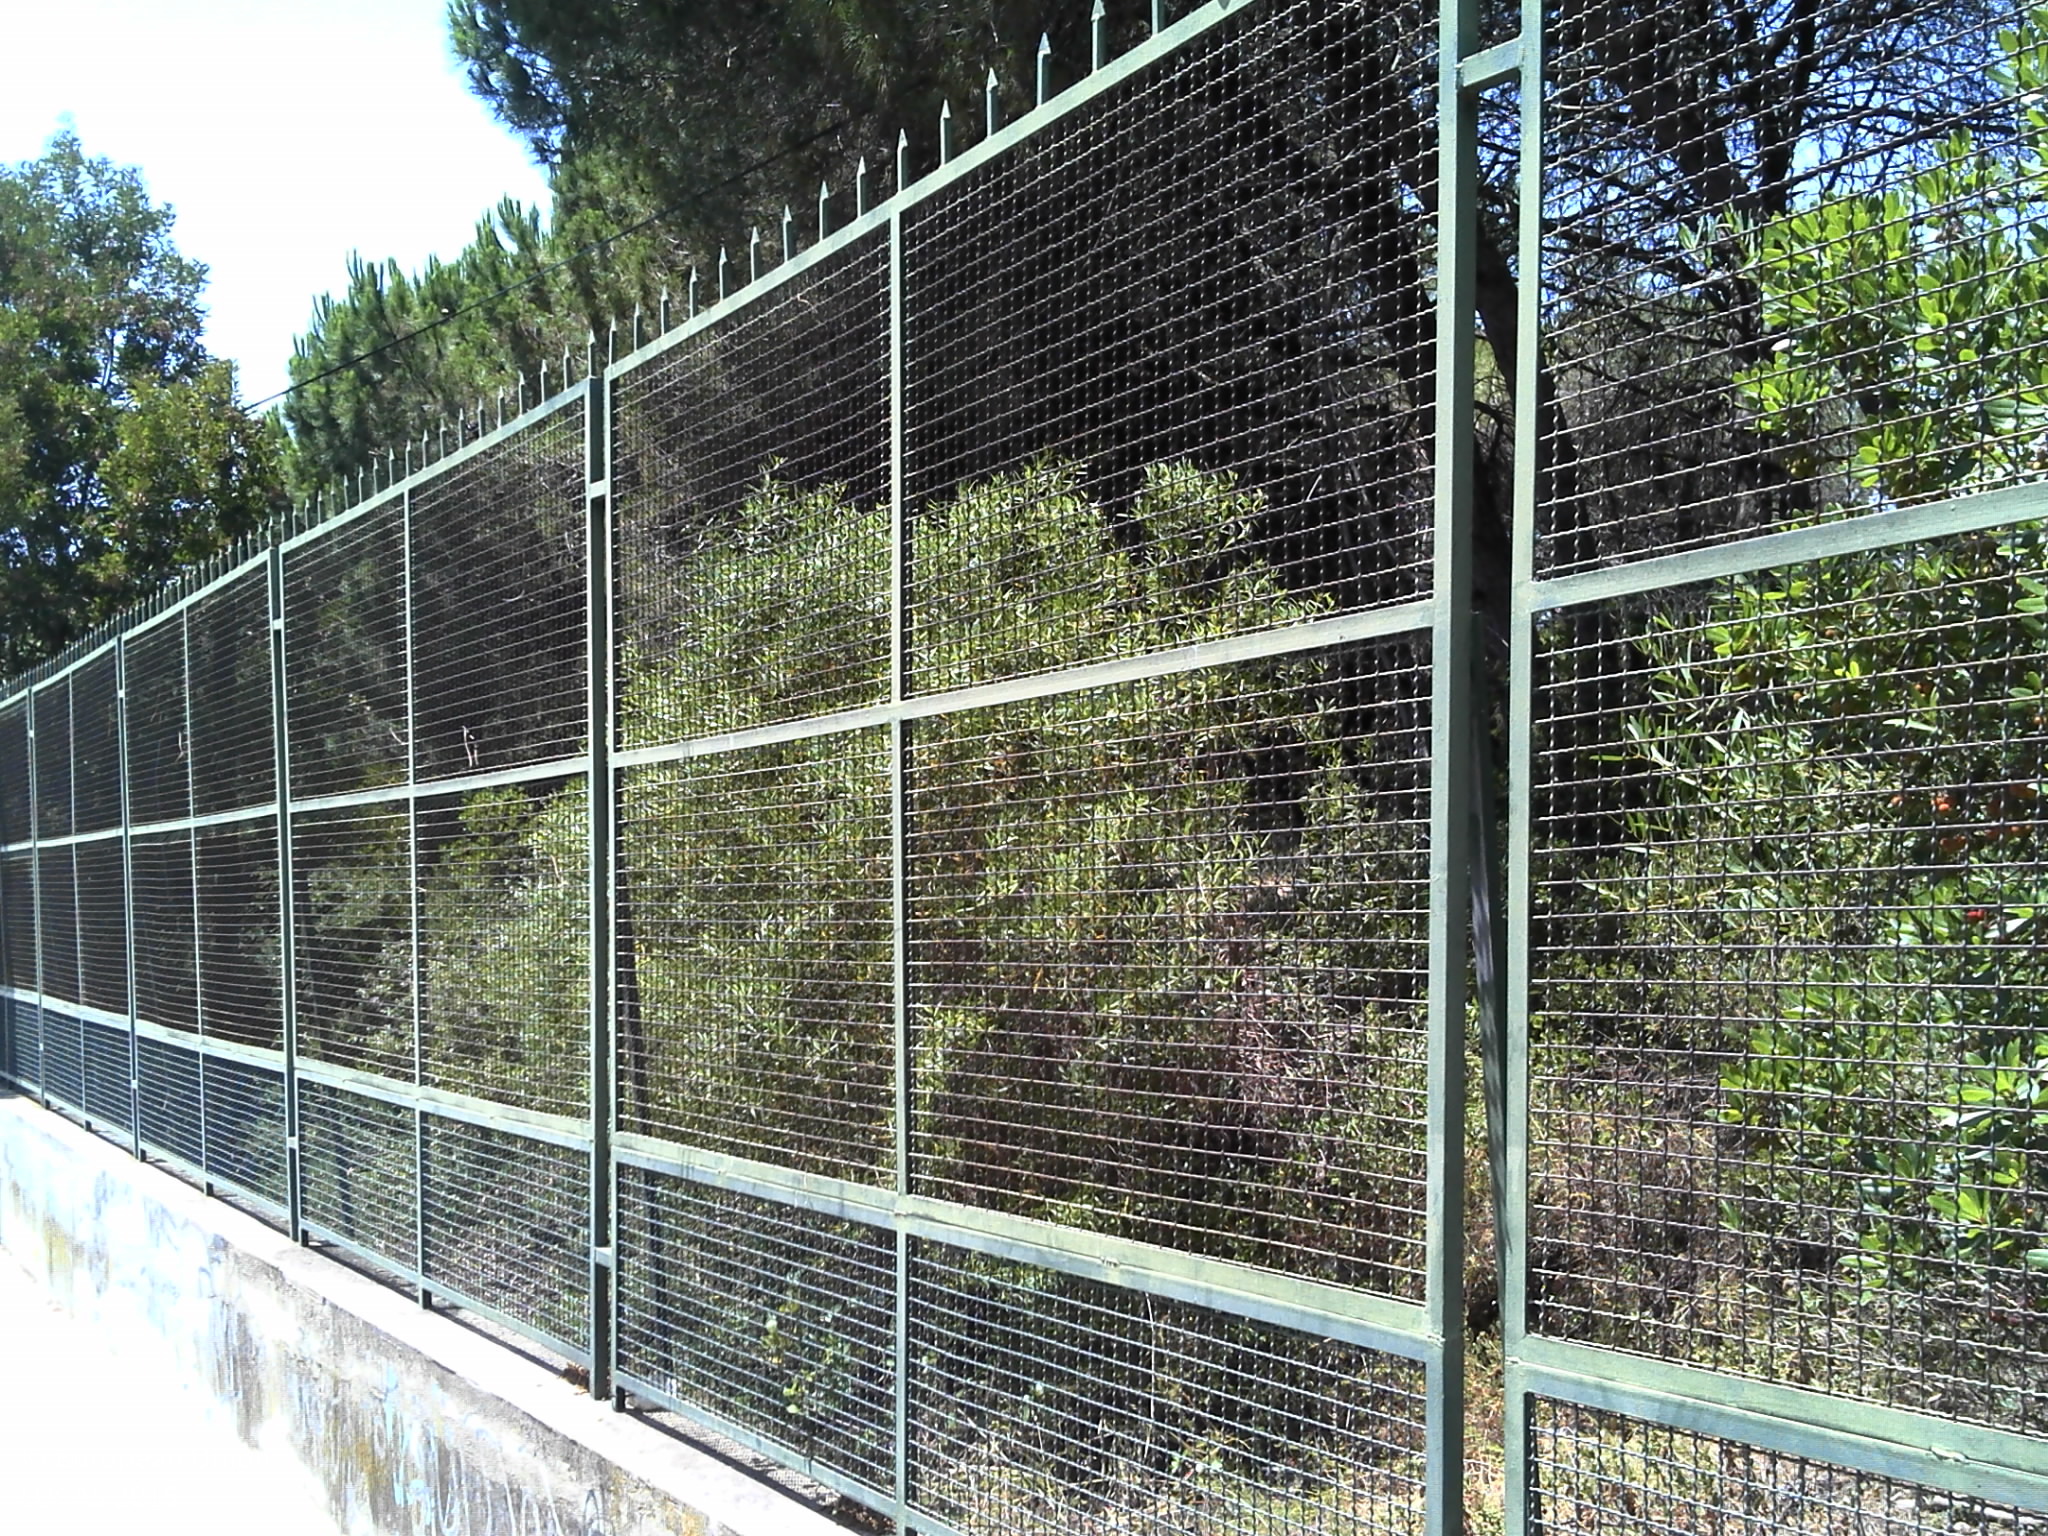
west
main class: Woodland
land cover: Pine dominated coniferous woodland
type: coniferous forest of the mediterranean region
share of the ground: 25 - 50 %
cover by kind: coniferous forest trees 35 %, shrubs 15 %, unconsolidated bare surface 15 %
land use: Forestry
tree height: > 5 m
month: June
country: PT
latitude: 38.6247
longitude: -9.1285
